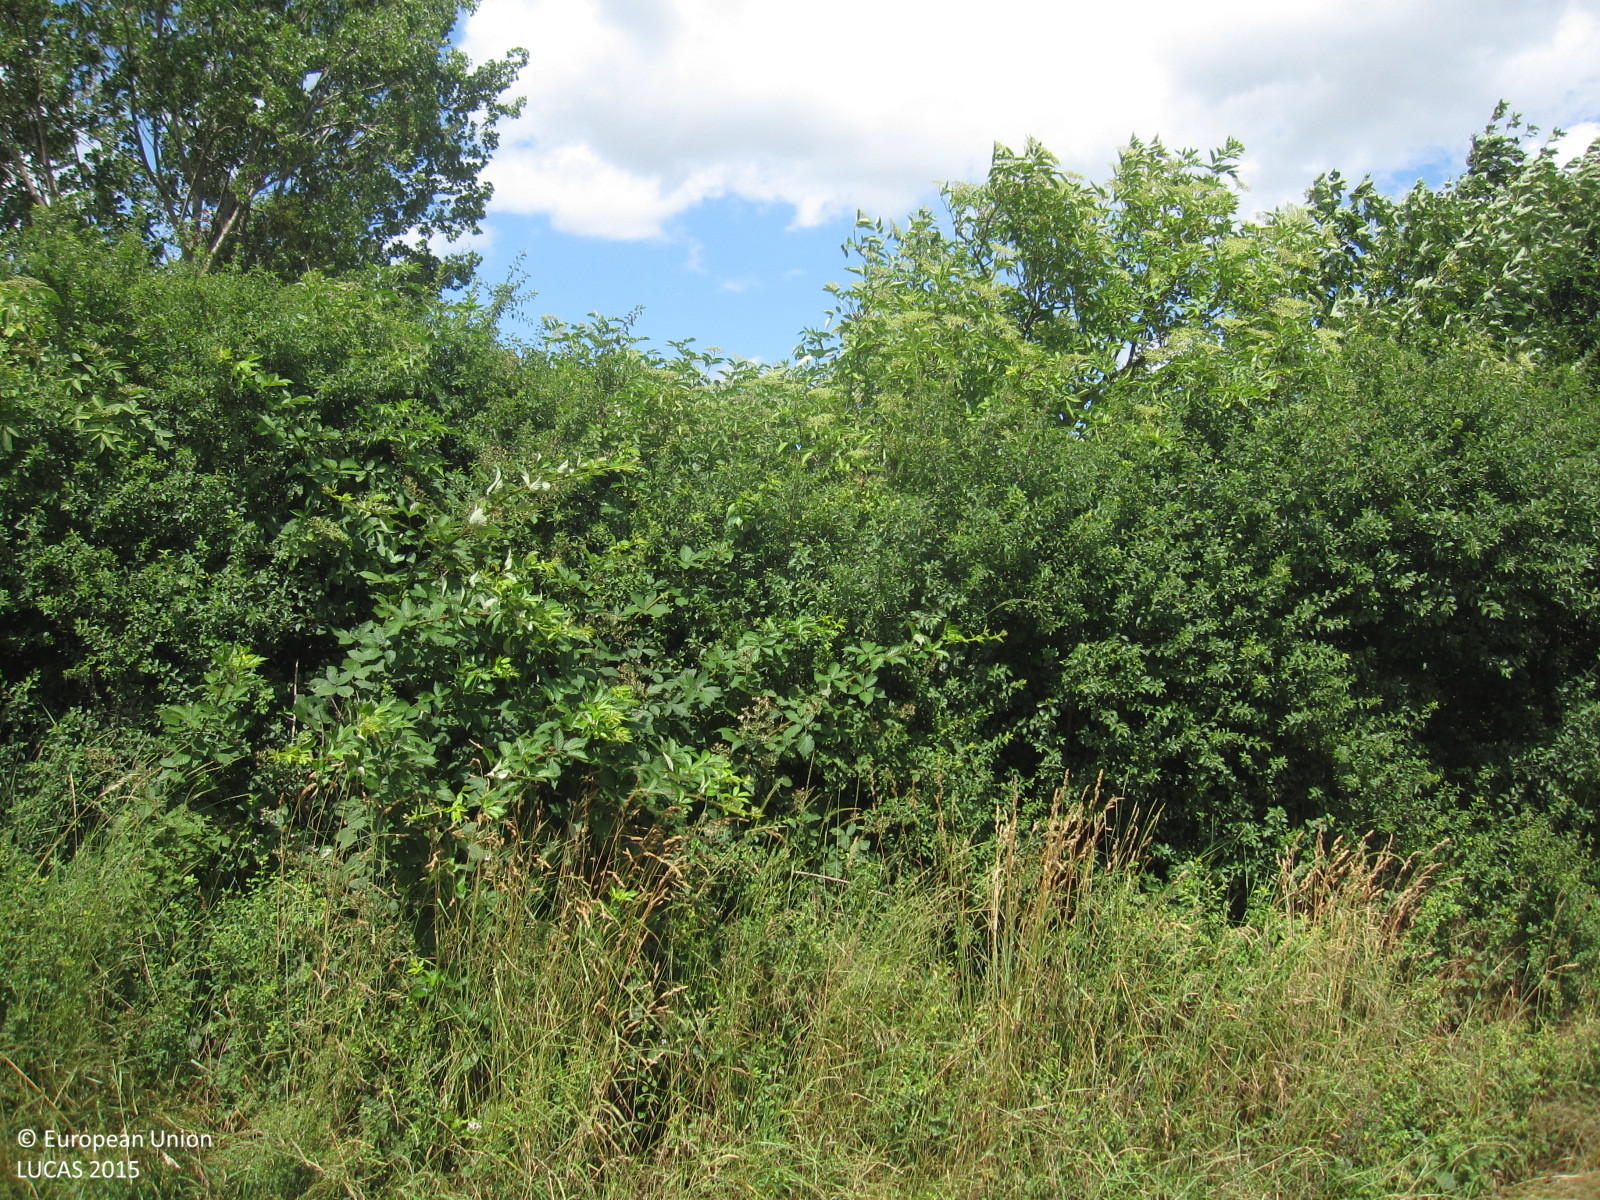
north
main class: Cropland
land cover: Rape and turnip rape
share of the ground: > 75 %
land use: Agriculture (excluding fallow land and kitchen gardens)
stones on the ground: < 10 %
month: July
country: DE
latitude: 50.9040
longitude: 12.0047
